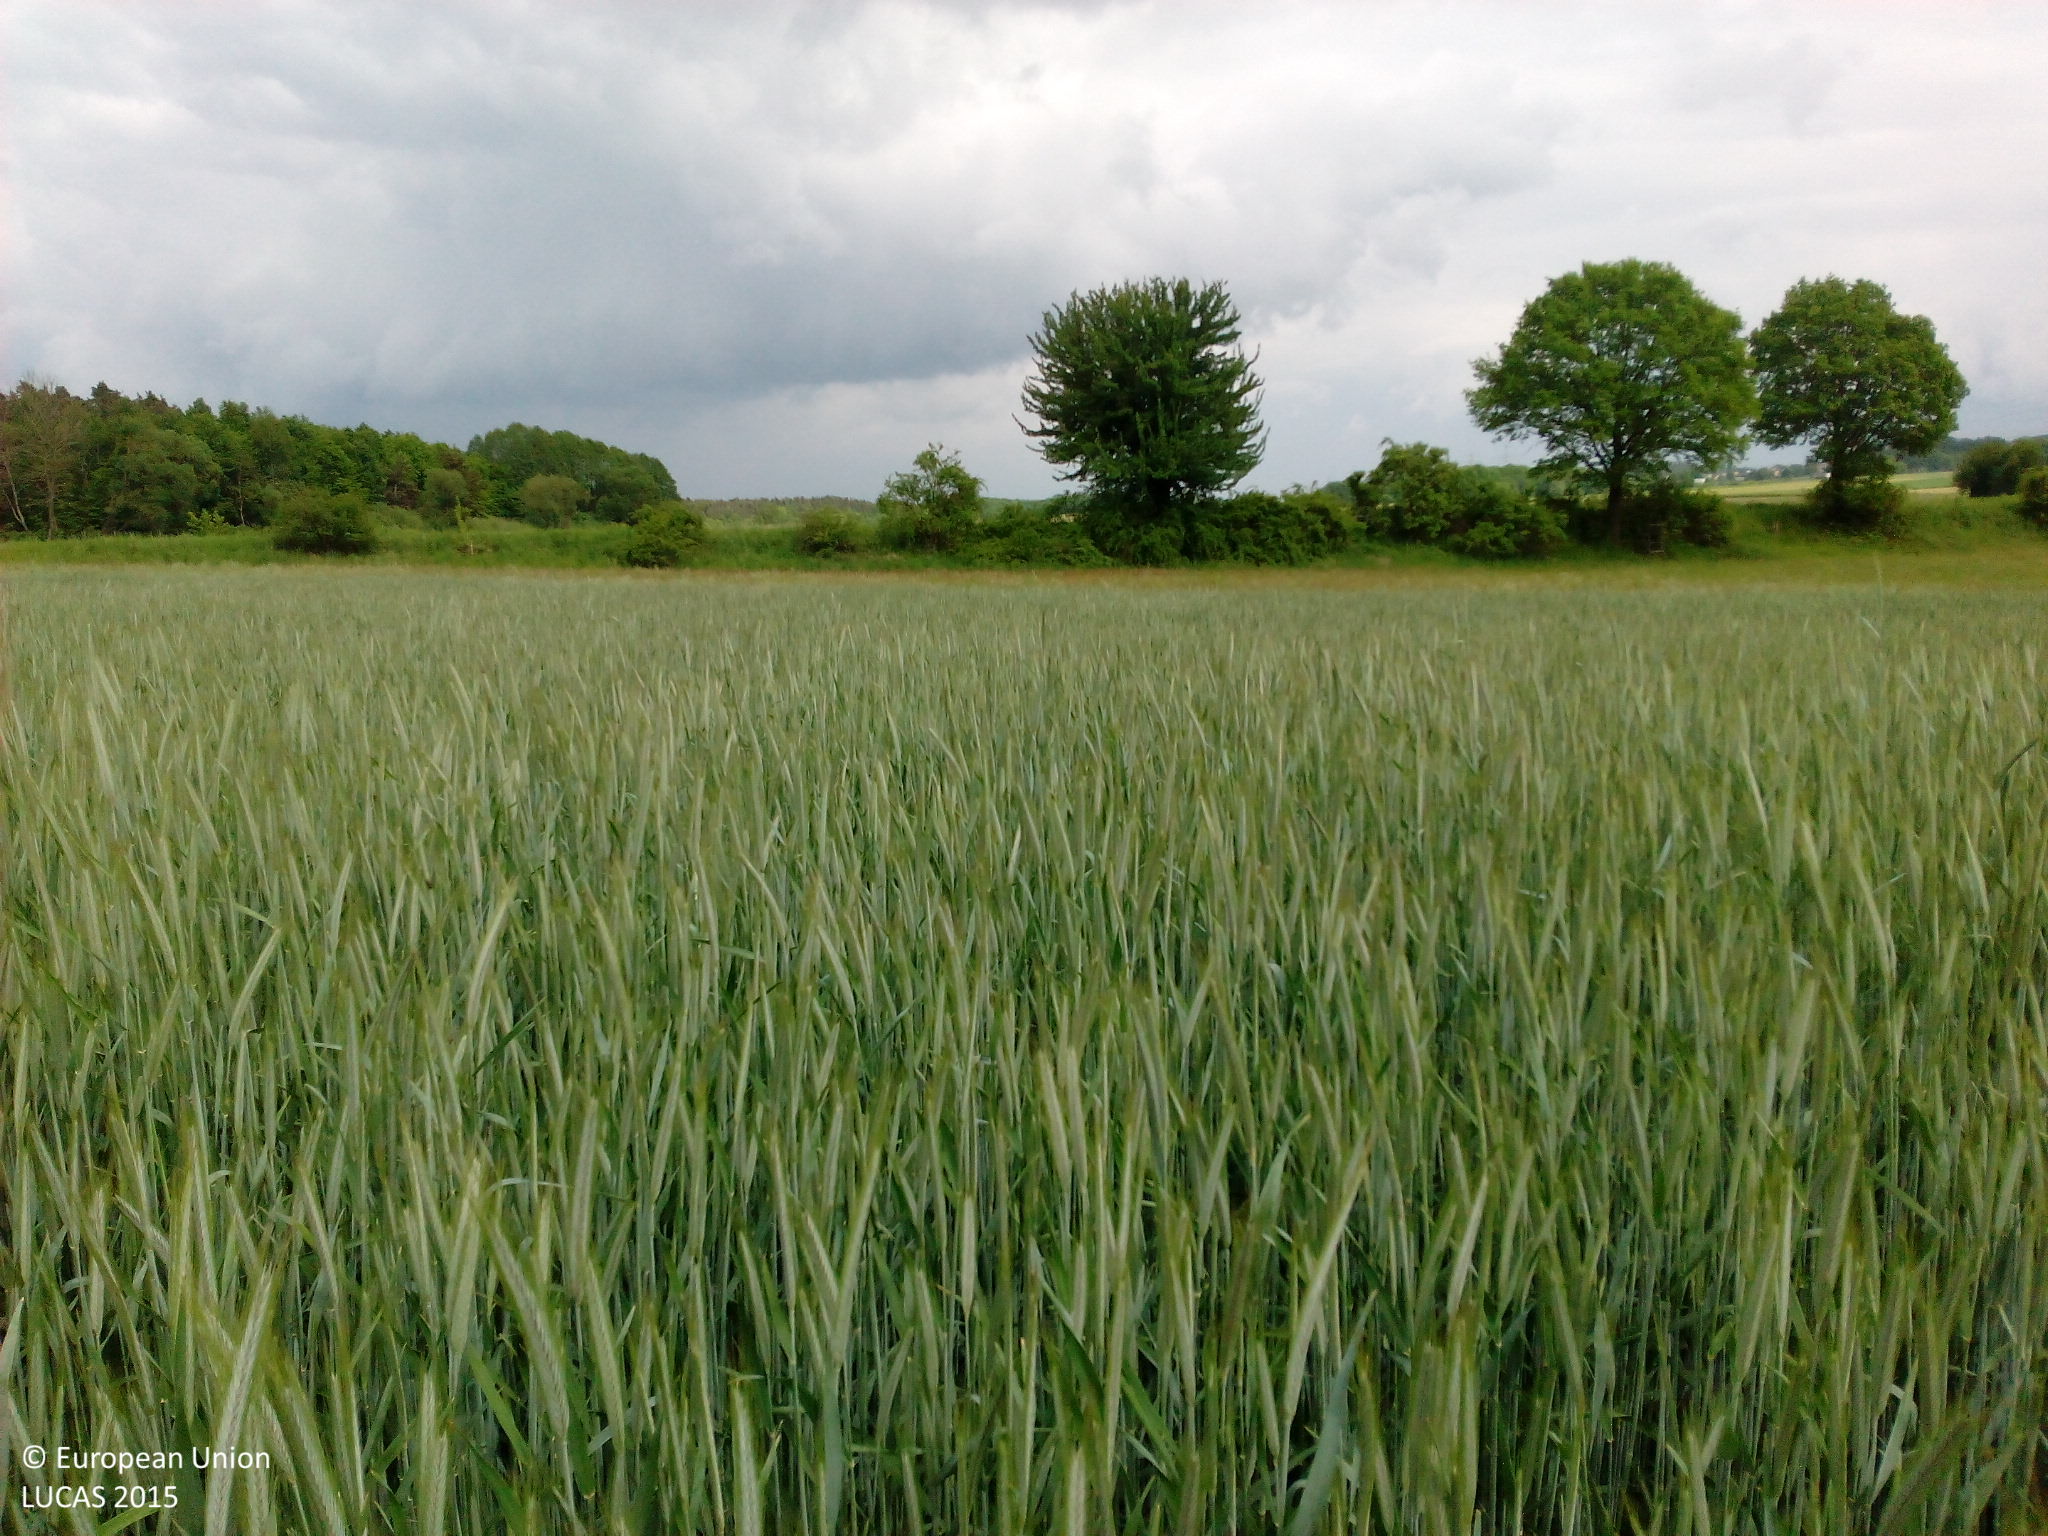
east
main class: Cropland
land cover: Rye
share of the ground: > 75 %
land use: Agriculture (excluding fallow land and kitchen gardens)
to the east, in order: Rye; Grass margins; Tracks; Grassland without tree/shrub cover; Managed hedges; Grass margins; Tracks; Grass margins; Inland fresh water bodies
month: May
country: DE
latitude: 49.2458
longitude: 12.1836
